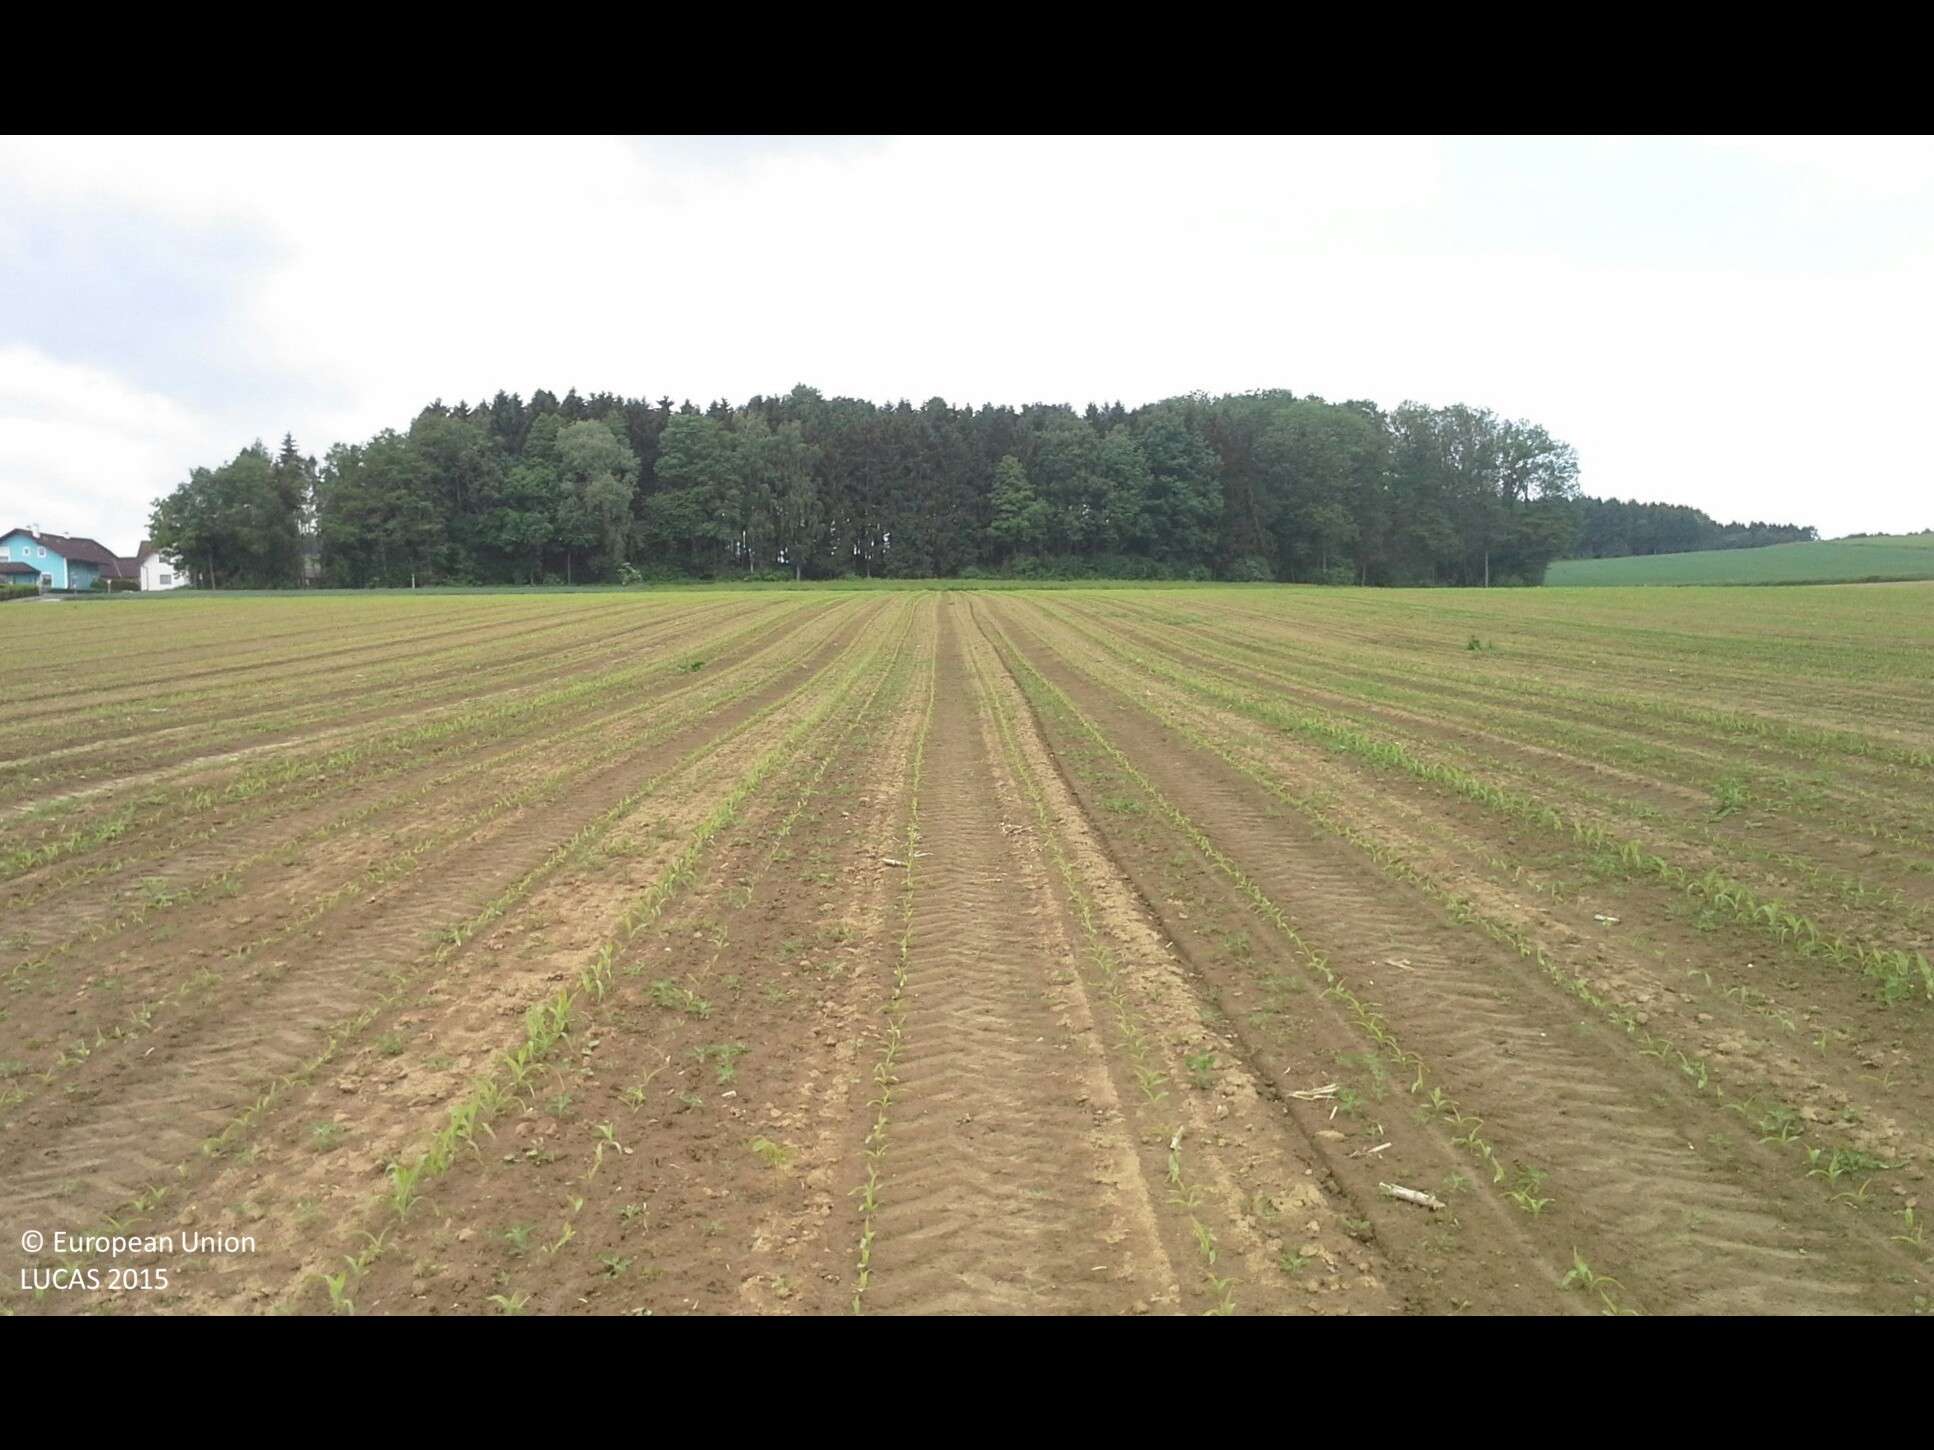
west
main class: Cropland
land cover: Maize
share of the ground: < 10 %
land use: Agriculture (excluding fallow land and kitchen gardens)
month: May
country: AT
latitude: 48.1529
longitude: 14.4226
